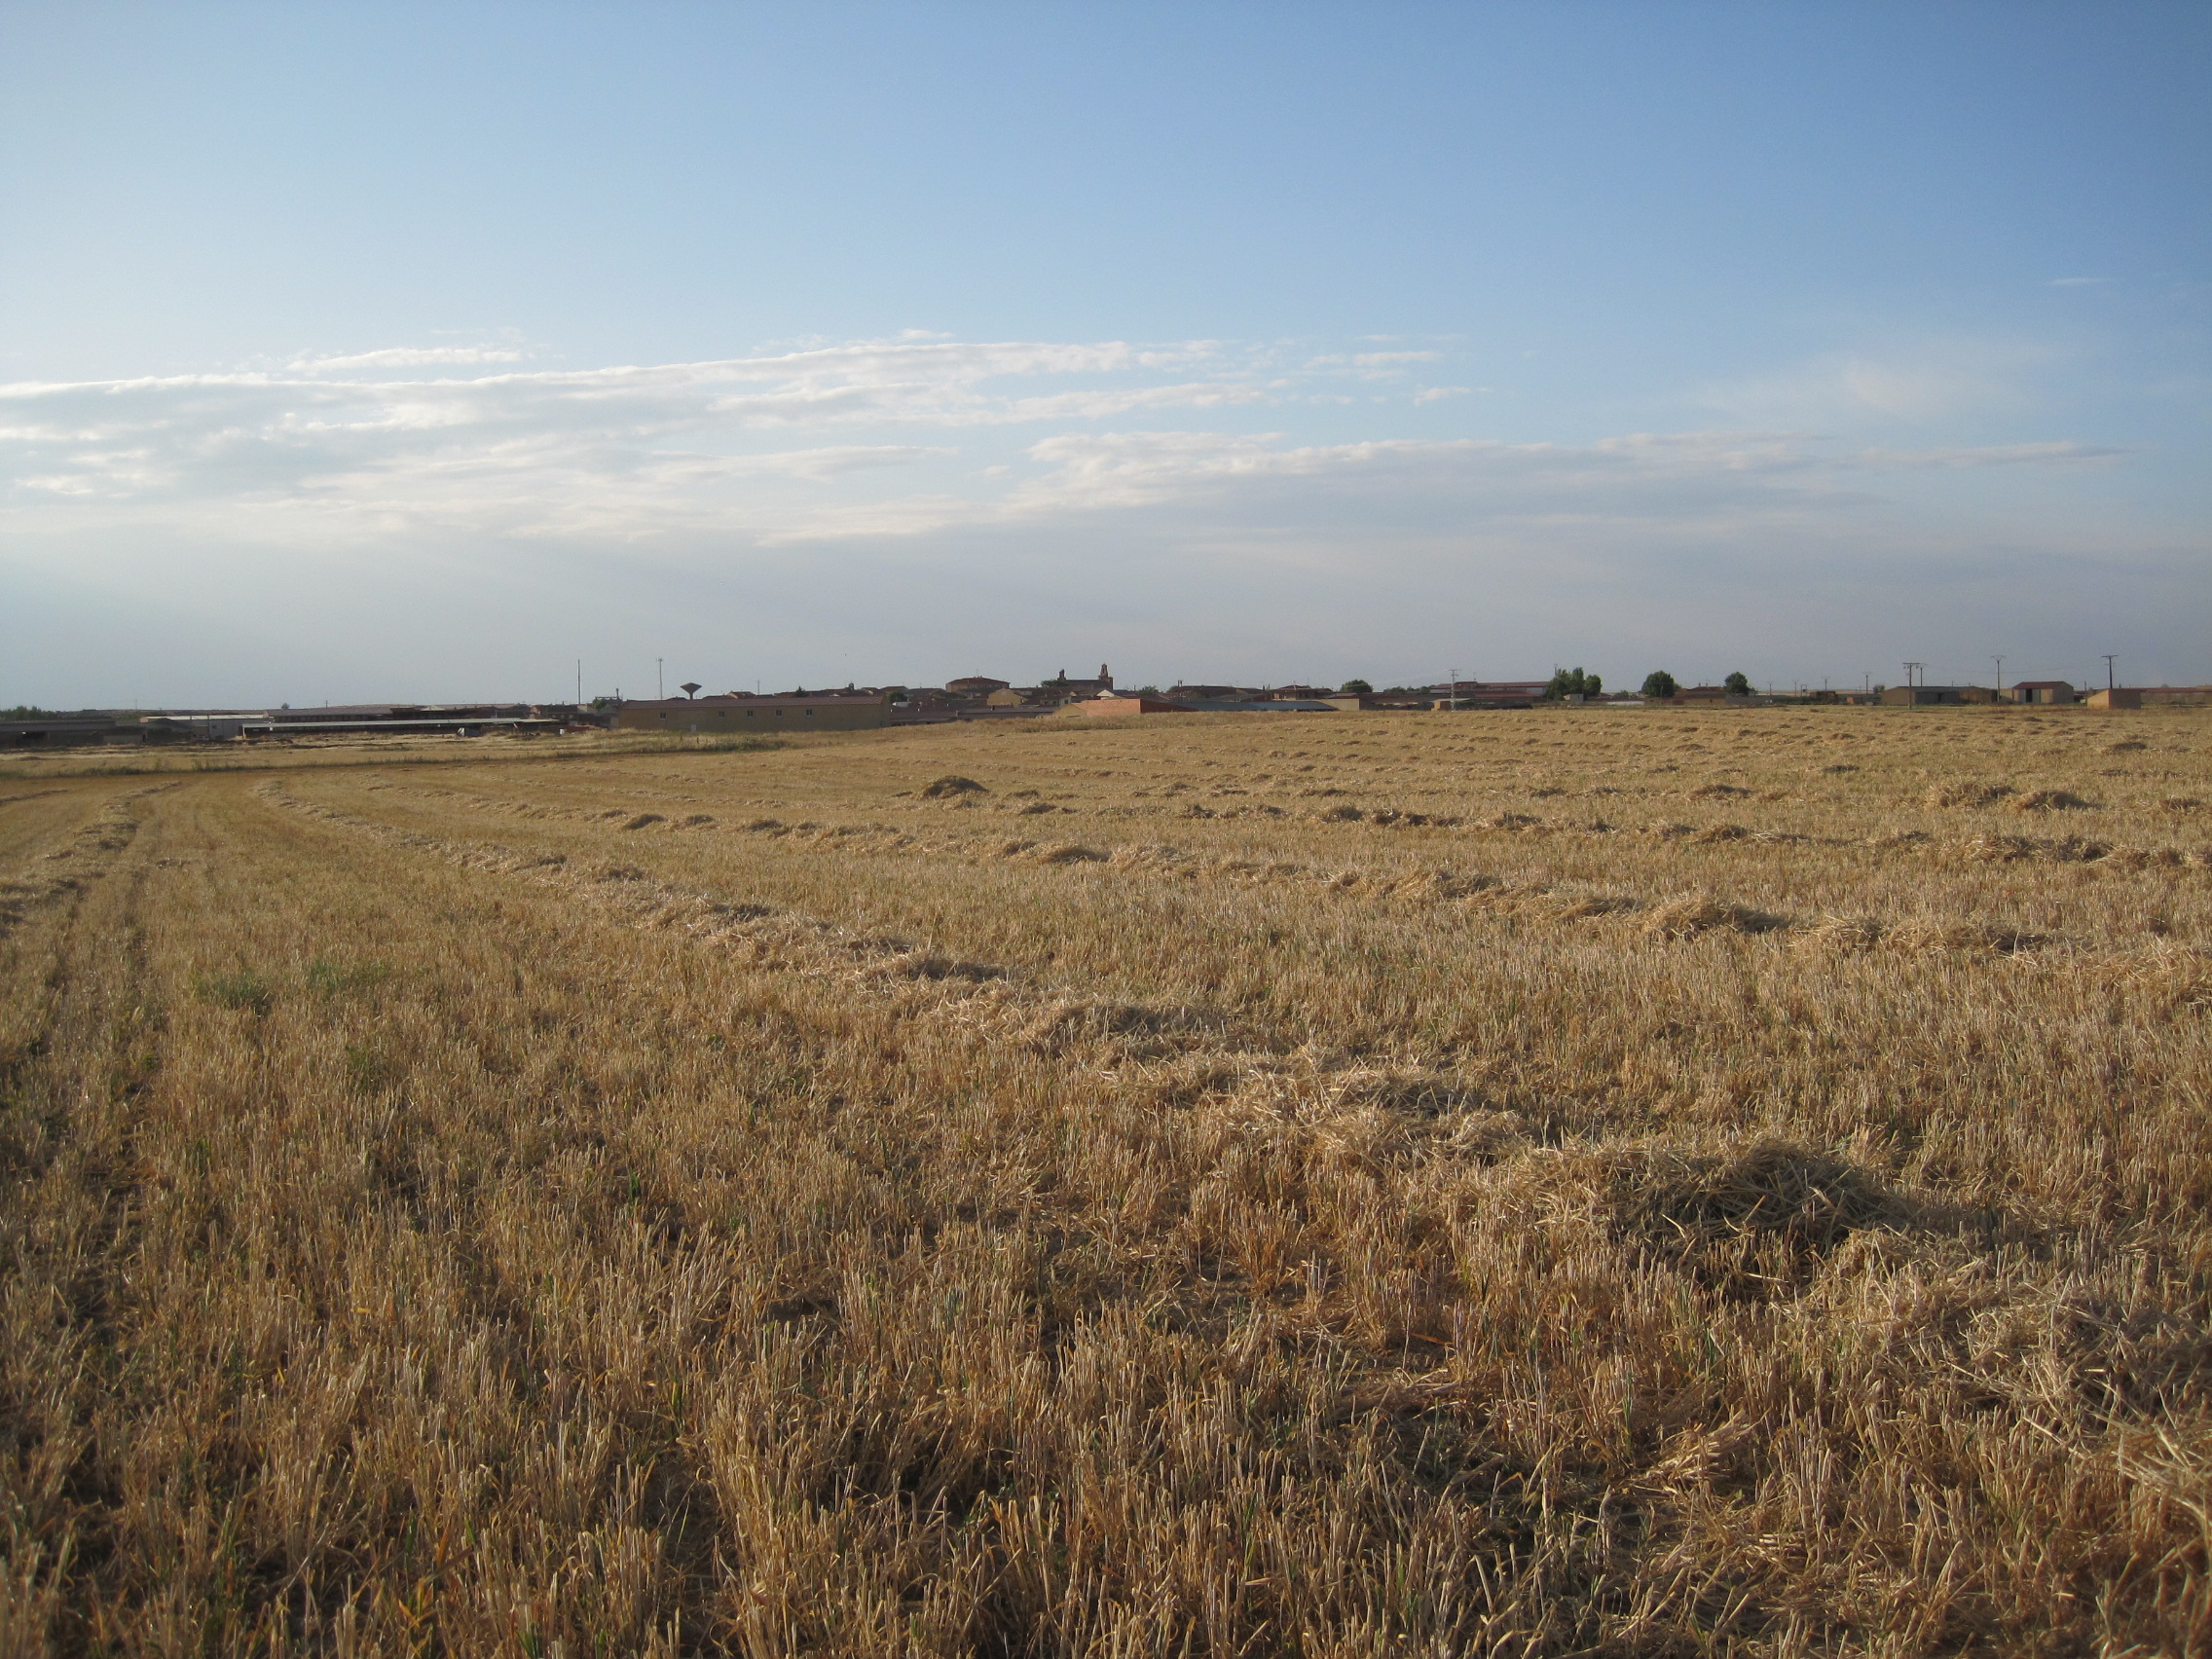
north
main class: Cropland
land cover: Barley
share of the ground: < 10 %
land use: Agriculture (excluding fallow land and kitchen gardens)
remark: Harvested field
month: July
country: ES
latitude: 41.8389
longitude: -5.6110
